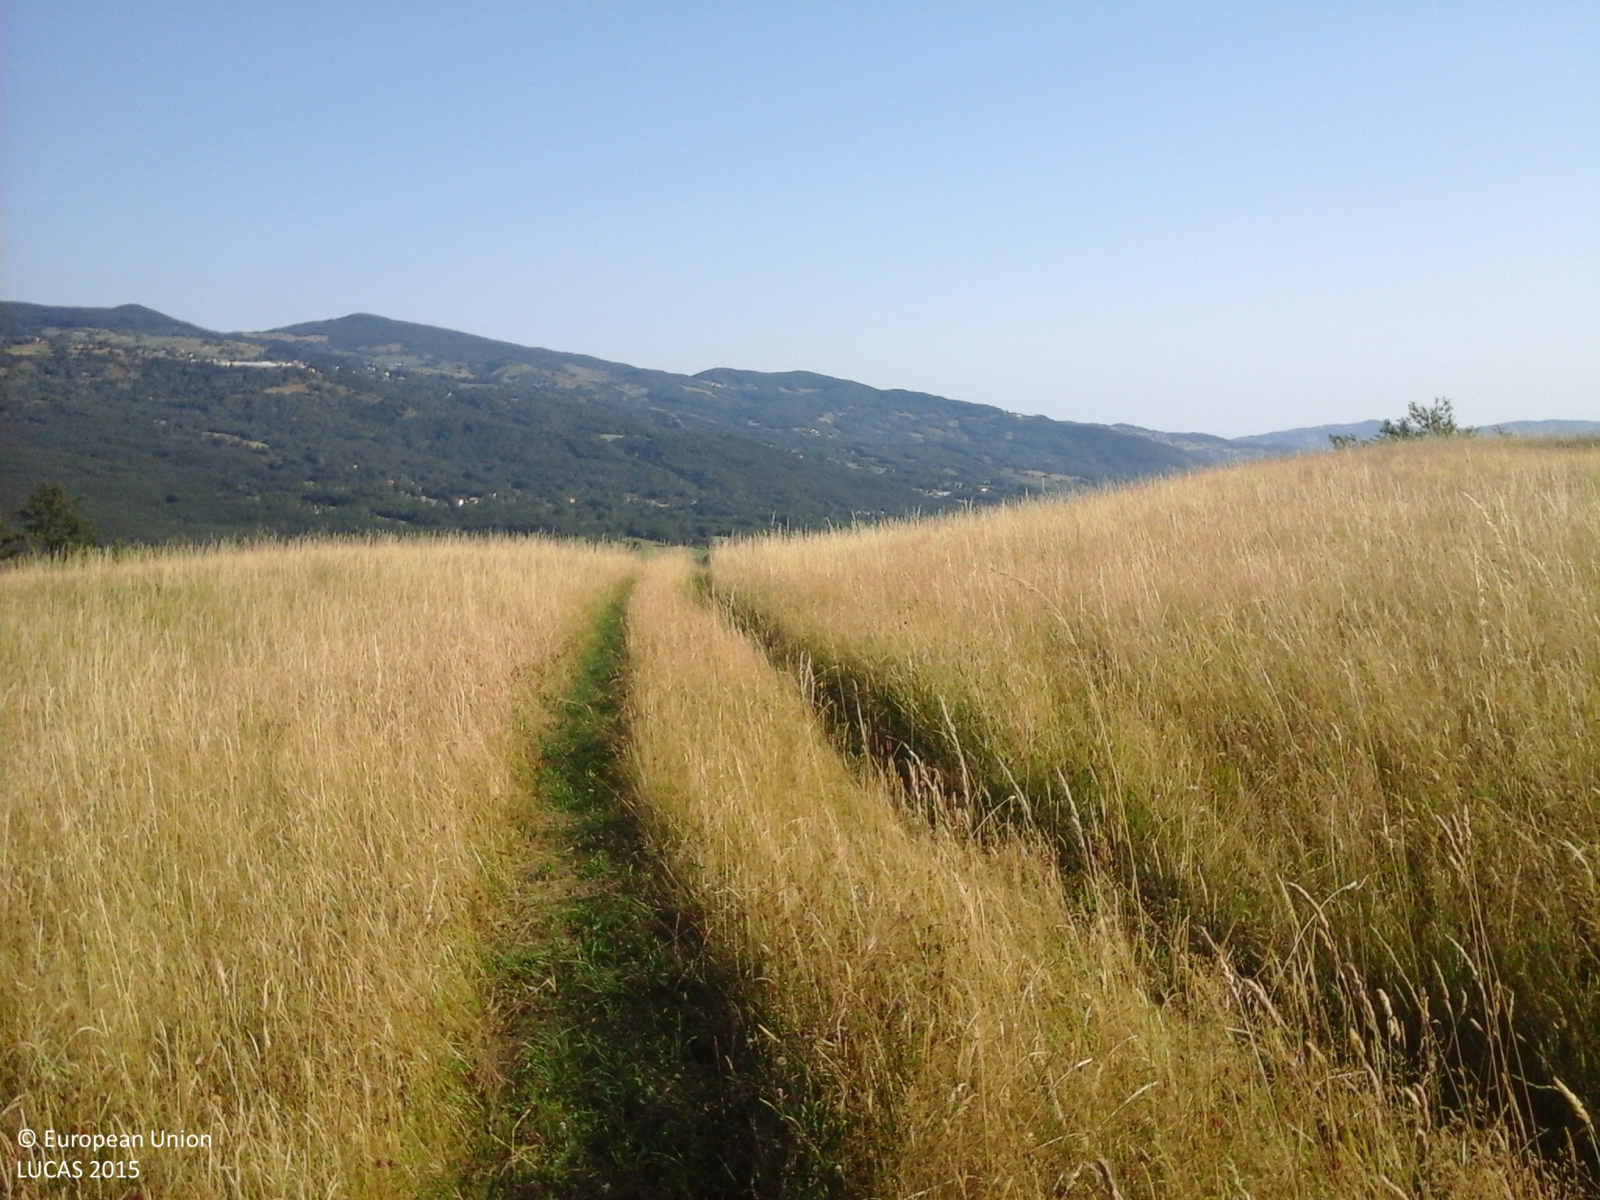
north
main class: Woodland
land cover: Broadleaved woodland
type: mountainous beech forest
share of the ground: > 75 %
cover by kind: broadleaved forest trees 100 %
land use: Forestry
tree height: > 5 m
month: July
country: IT
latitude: 44.2587
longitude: 10.5873
